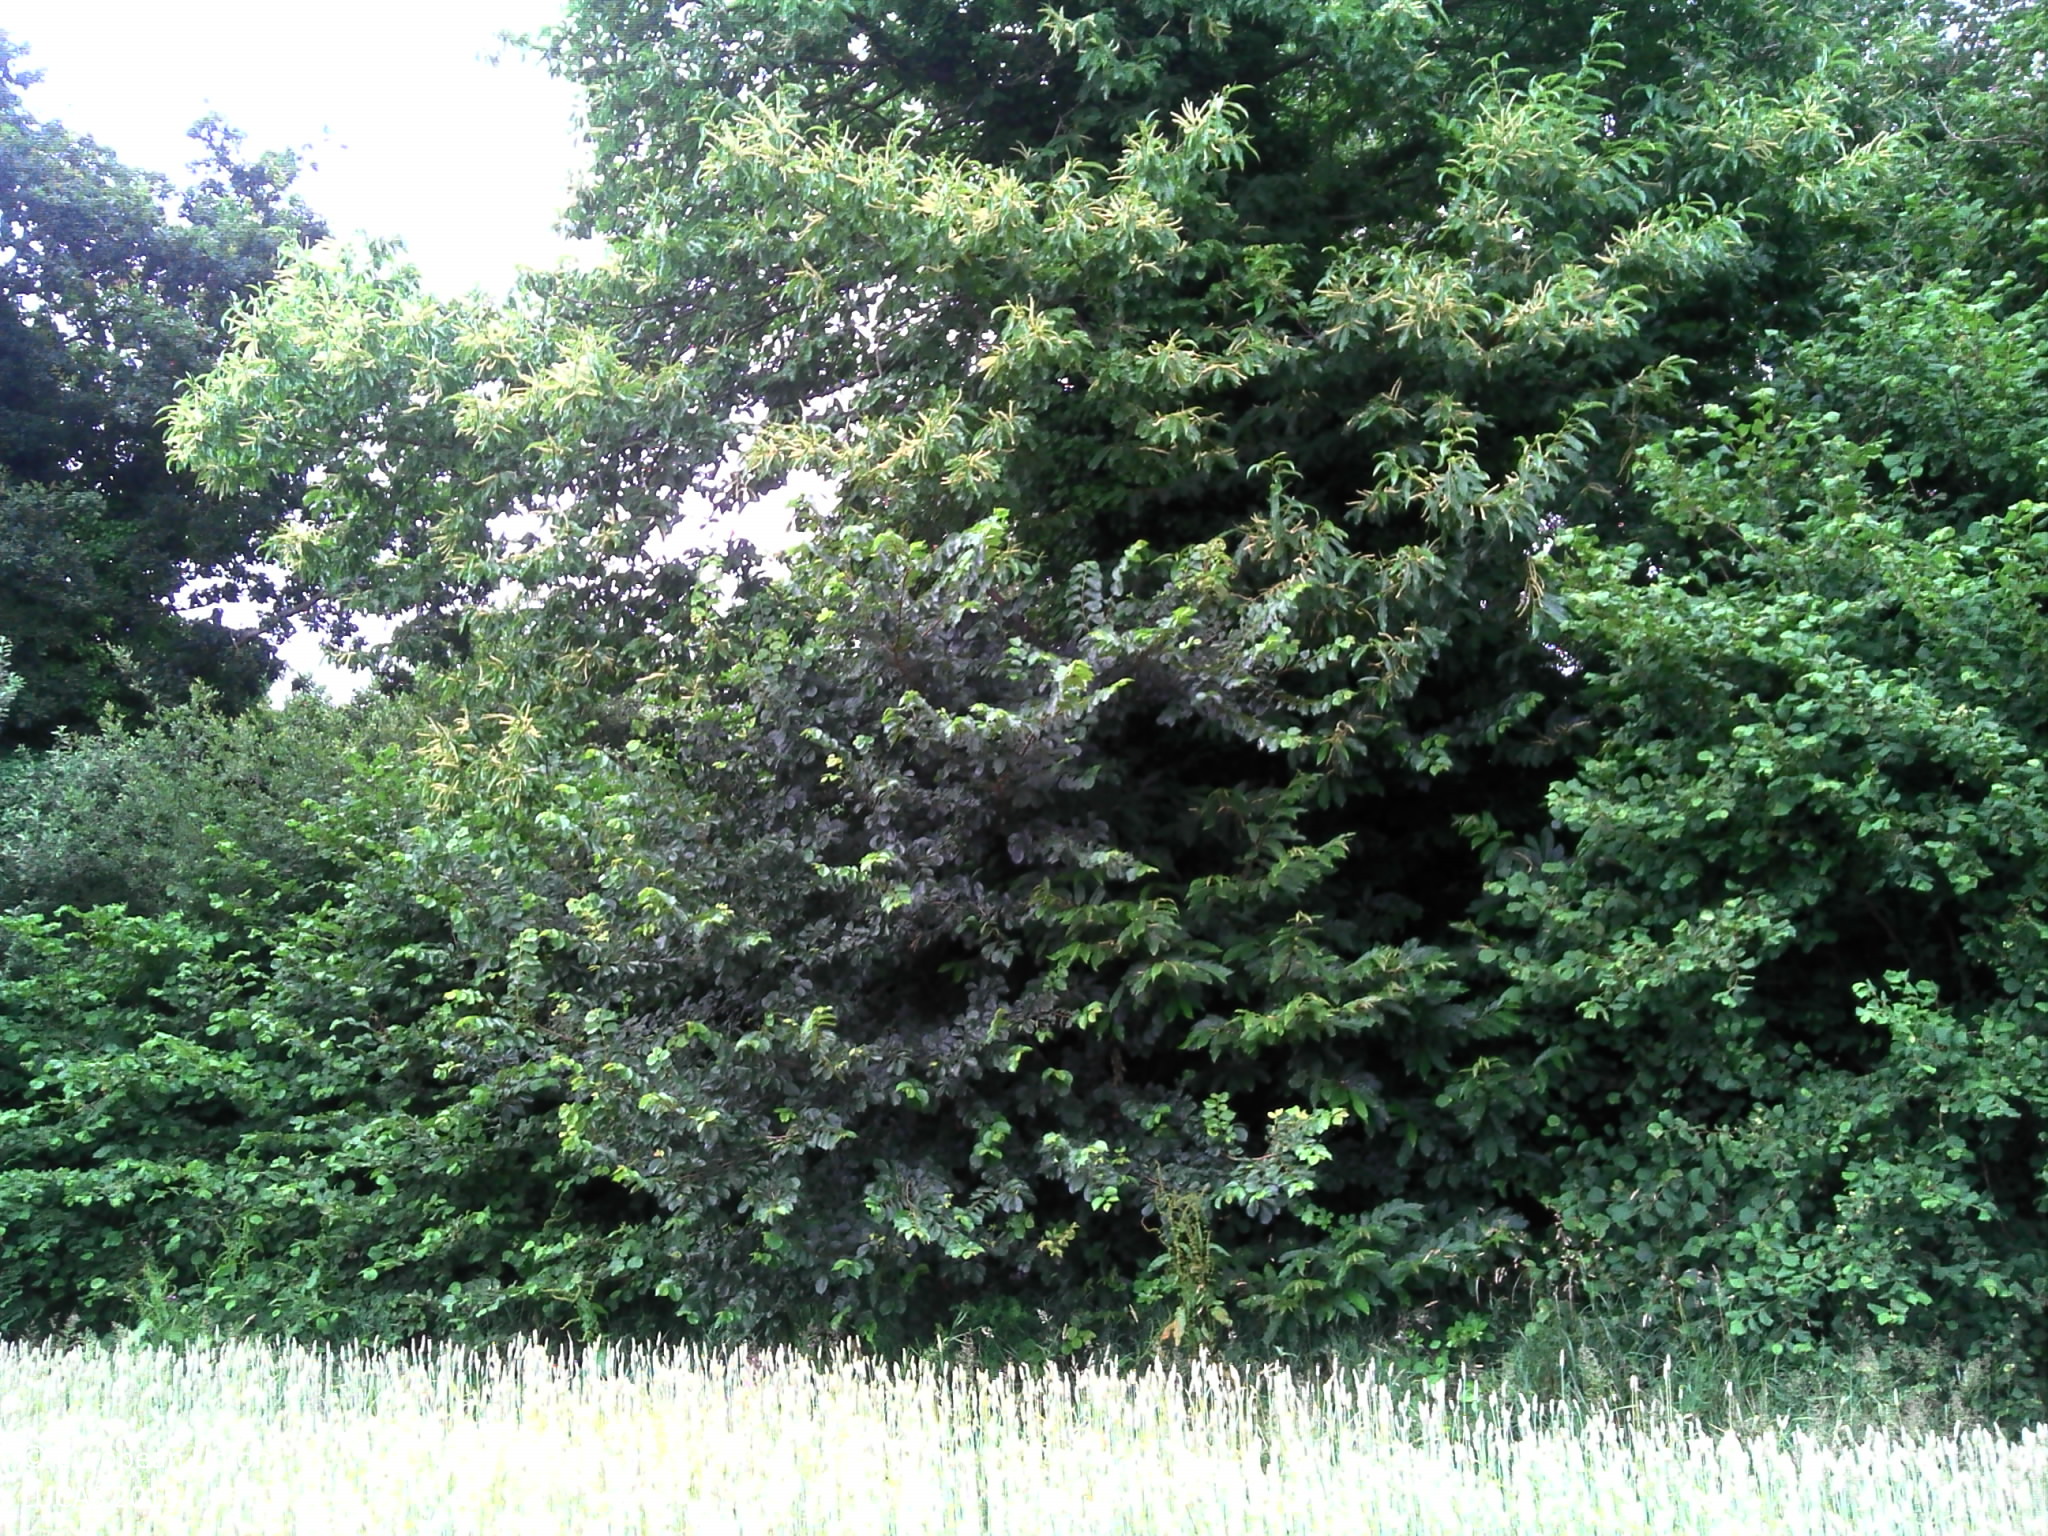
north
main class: Cropland
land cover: Common wheat
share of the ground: > 75 %
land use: Agriculture (excluding fallow land and kitchen gardens)
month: July
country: FR
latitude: 48.6676
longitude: -3.4813
